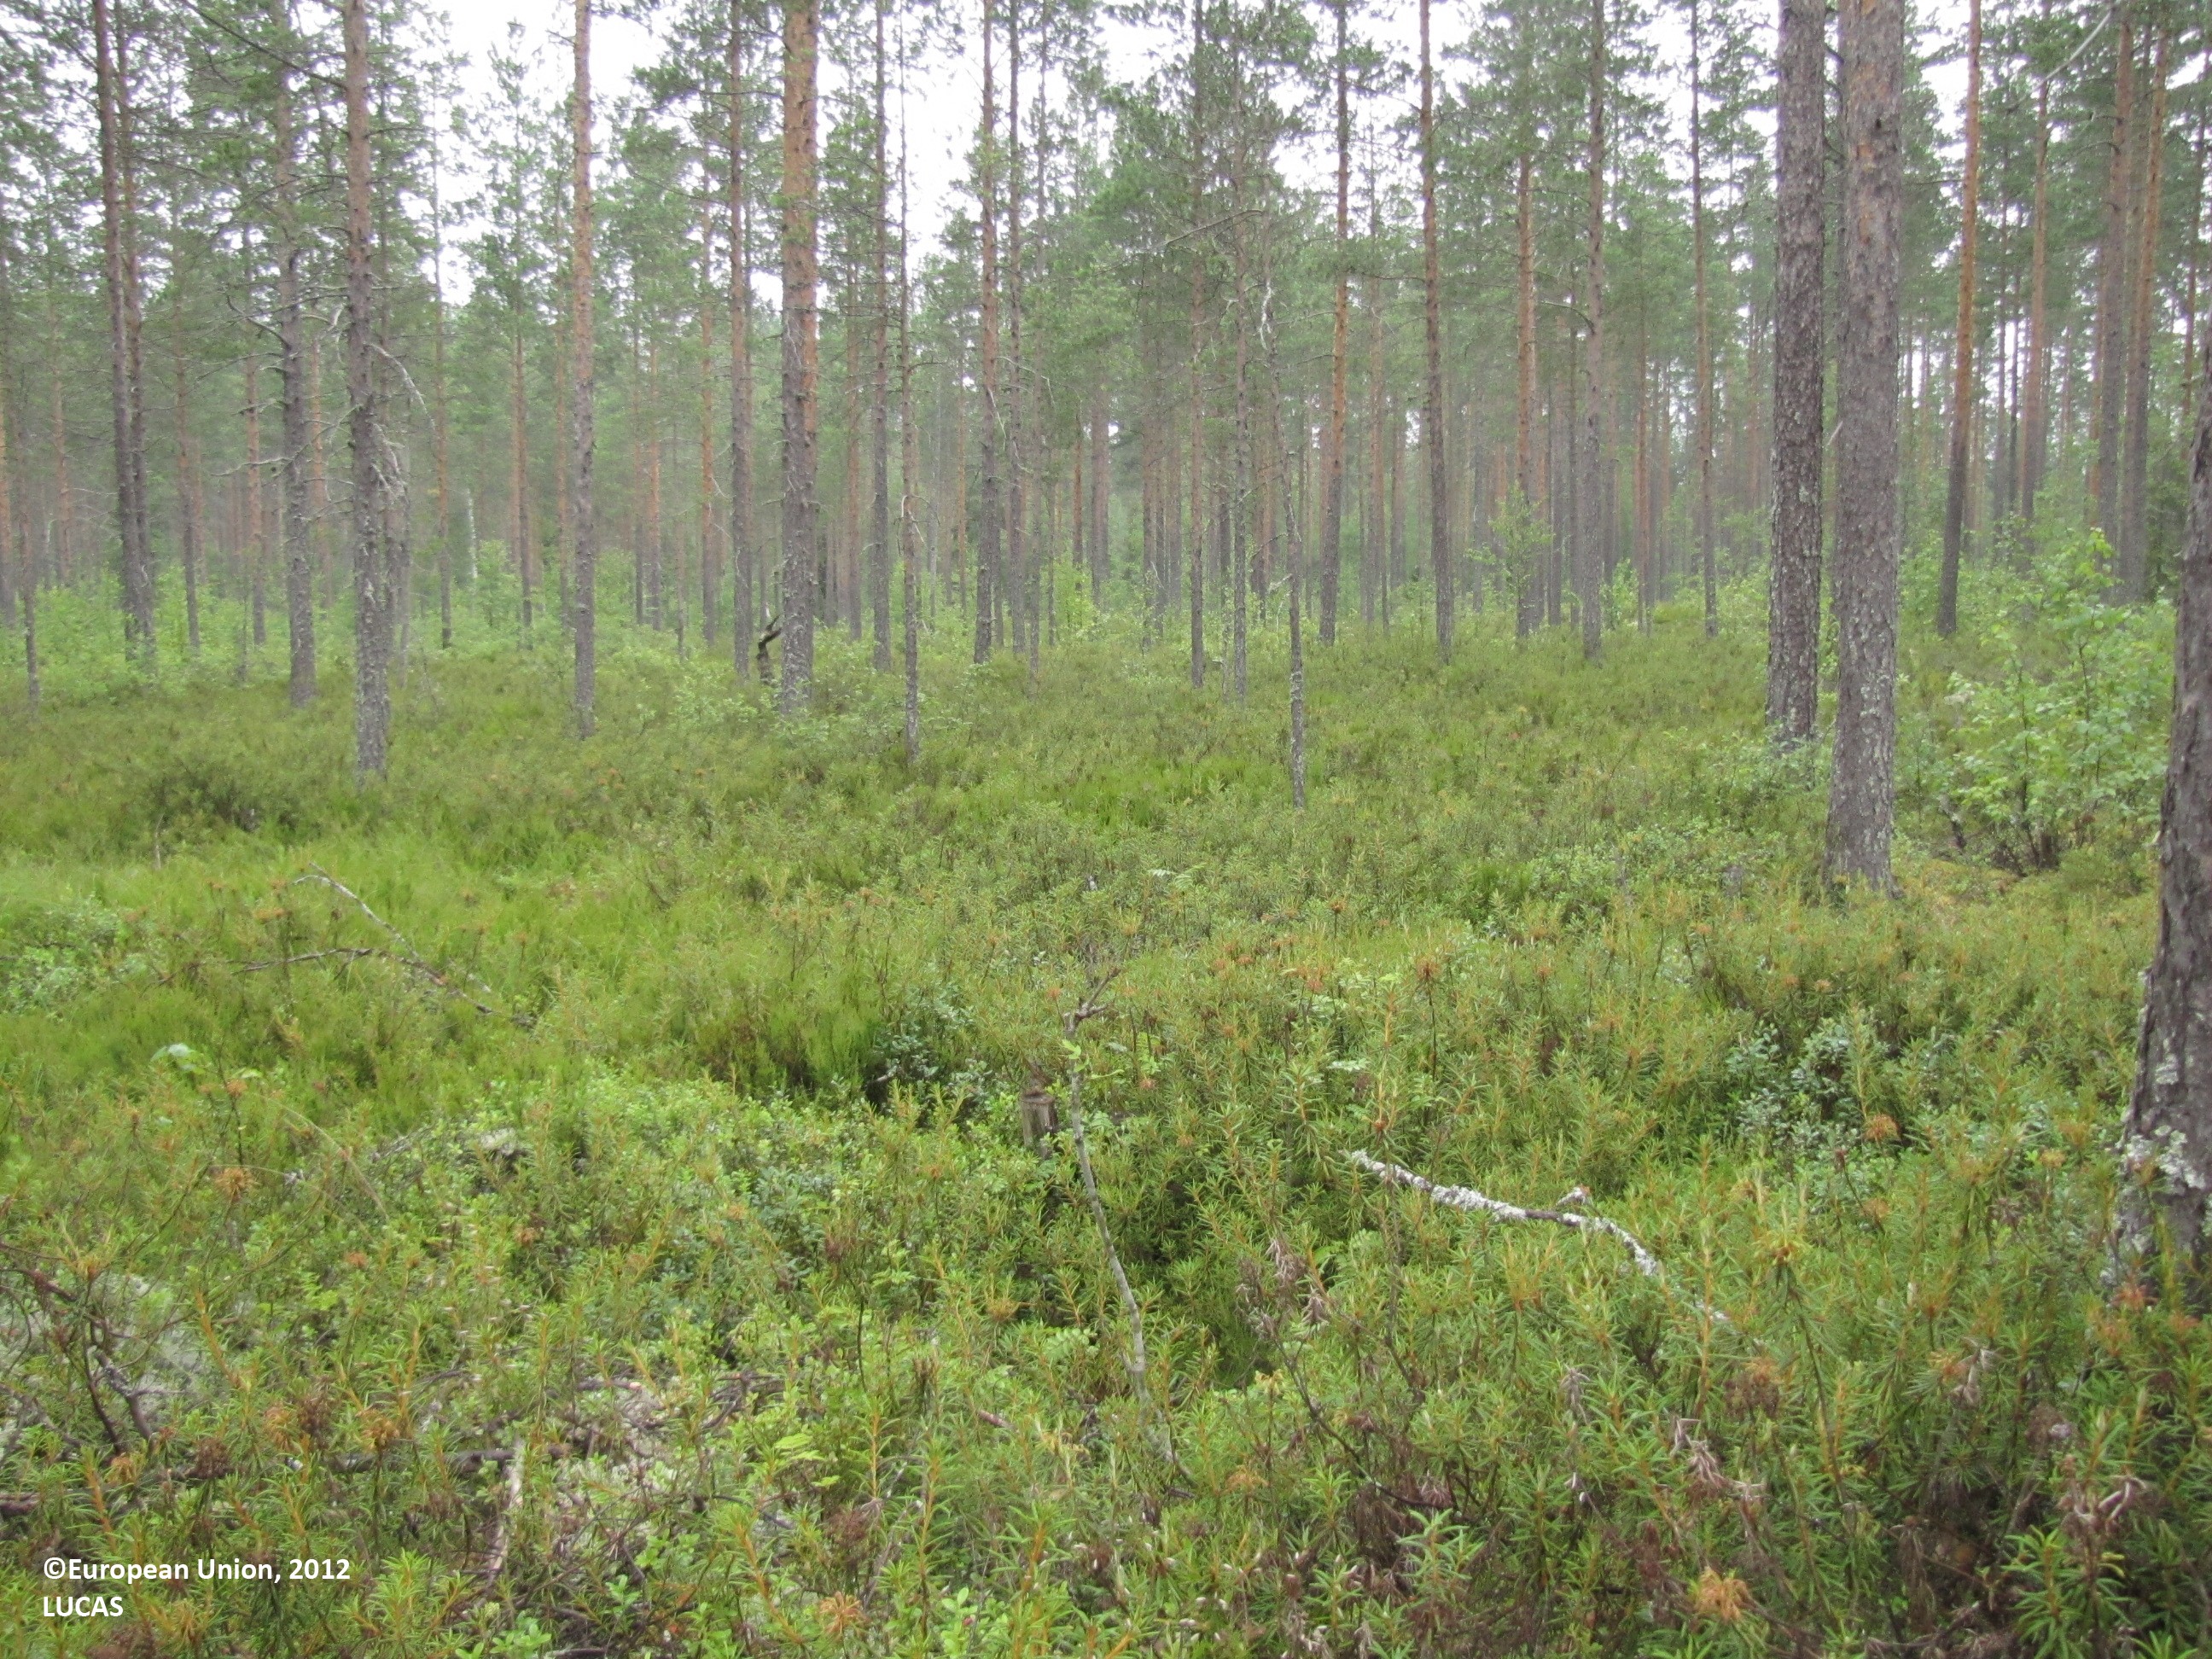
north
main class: Woodland
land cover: Pine dominated coniferous woodland
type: boreal forest
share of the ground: 50 - 75 %
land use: Forestry
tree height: > 5 m
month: July
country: FI
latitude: 62.0866
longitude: 22.9524
